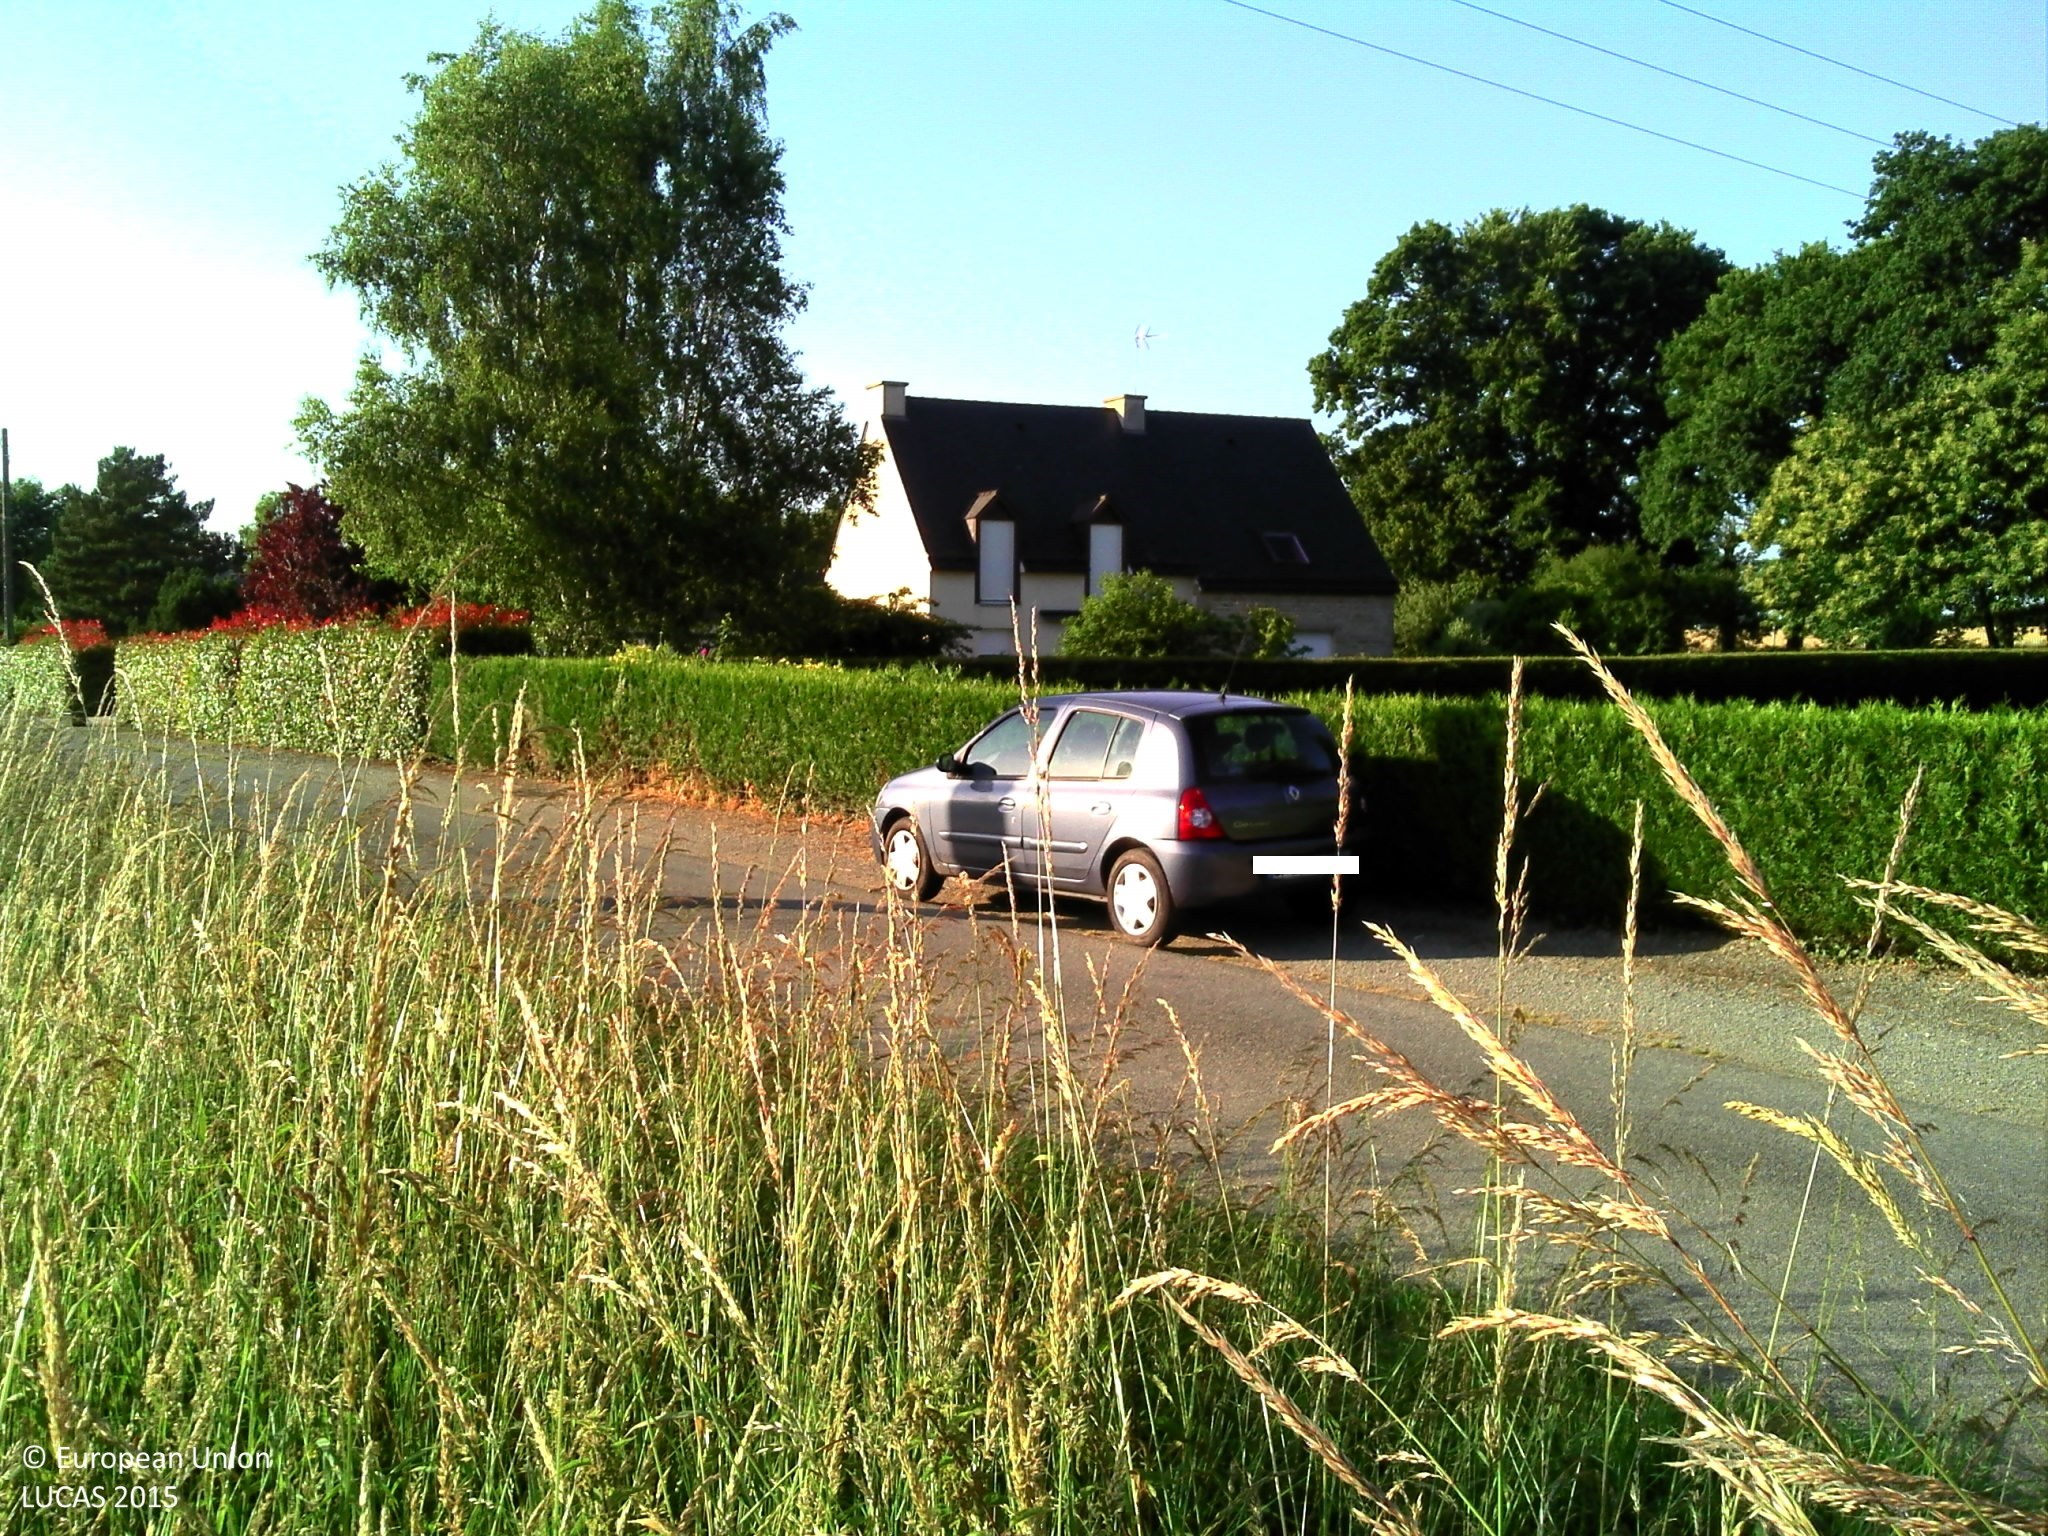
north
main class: Cropland
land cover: Common wheat
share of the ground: > 75 %
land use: Agriculture (excluding fallow land and kitchen gardens)
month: July
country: FR
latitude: 48.4337
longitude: -2.2079
